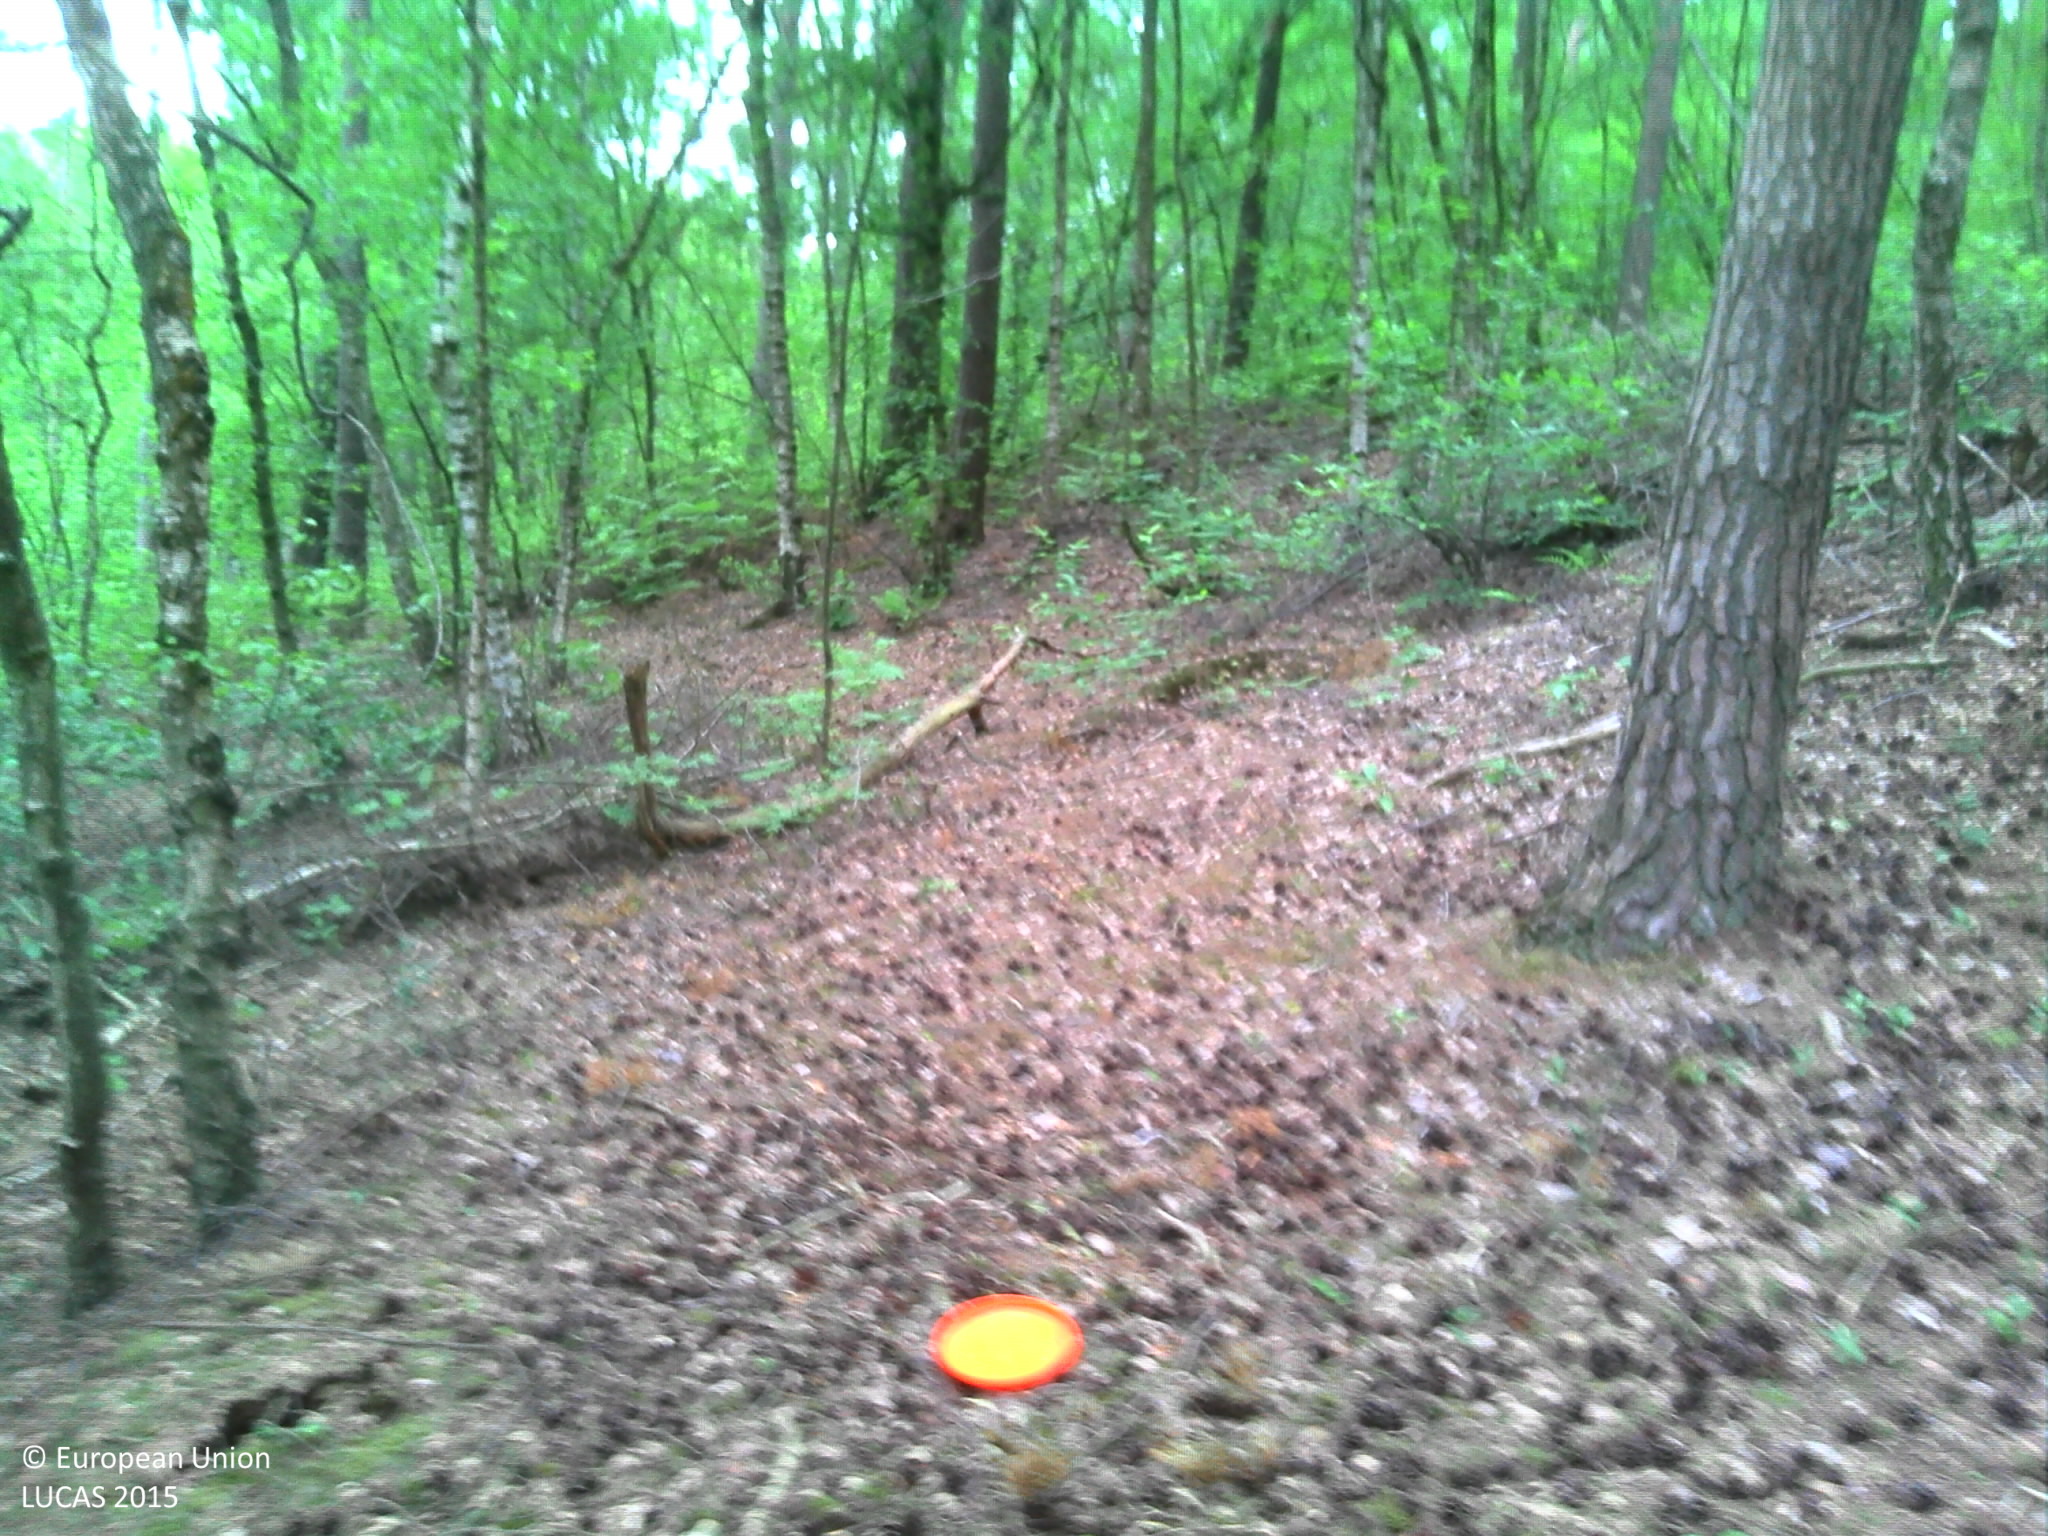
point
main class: Woodland
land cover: Pine dominated coniferous woodland
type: exotic forest
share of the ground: > 75 %
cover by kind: coniferous forest trees 100 %
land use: Forestry
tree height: > 5 m
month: May
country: BE
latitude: 50.7204
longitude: 4.5426
